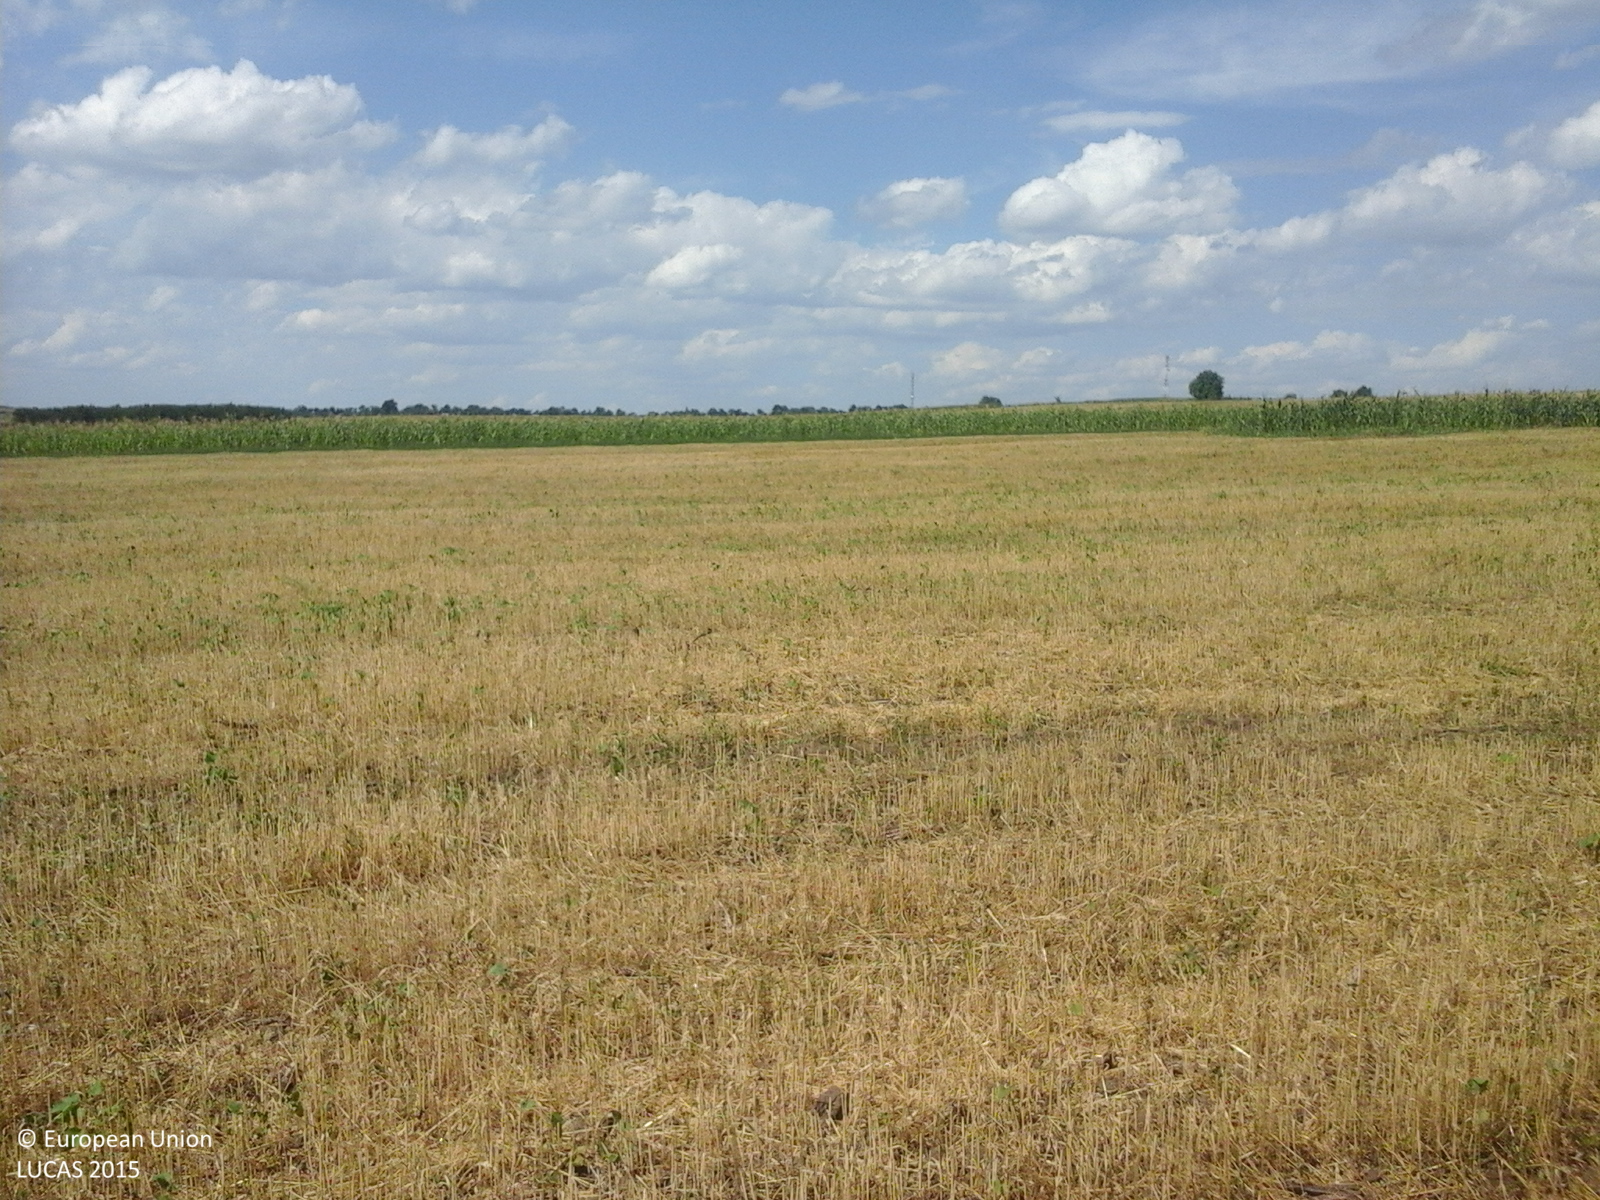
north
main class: Cropland
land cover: Common wheat
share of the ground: 10 - 25 %
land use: Agriculture (excluding fallow land and kitchen gardens)
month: July
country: RO
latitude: 46.4658
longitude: 27.7904
